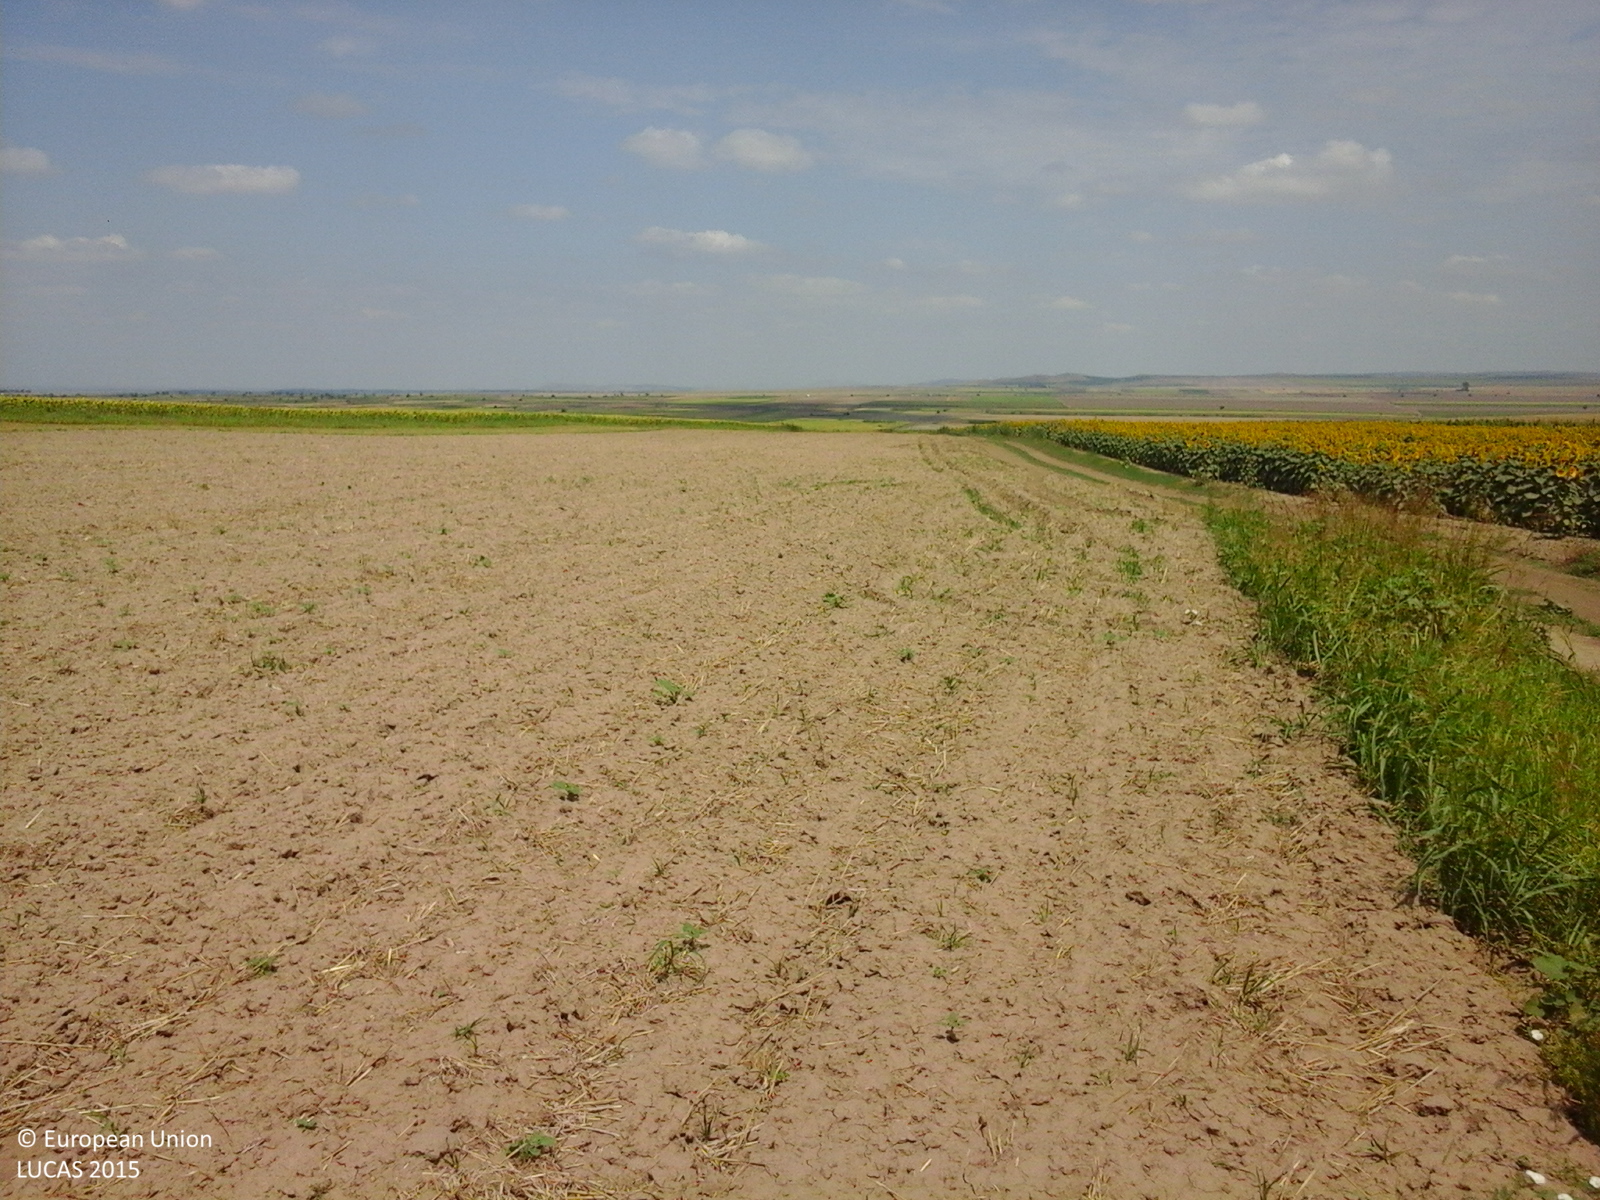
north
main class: Cropland
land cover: Common wheat
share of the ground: < 10 %
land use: Agriculture (excluding fallow land and kitchen gardens)
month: August
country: RO
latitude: 44.8163
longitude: 28.1611
